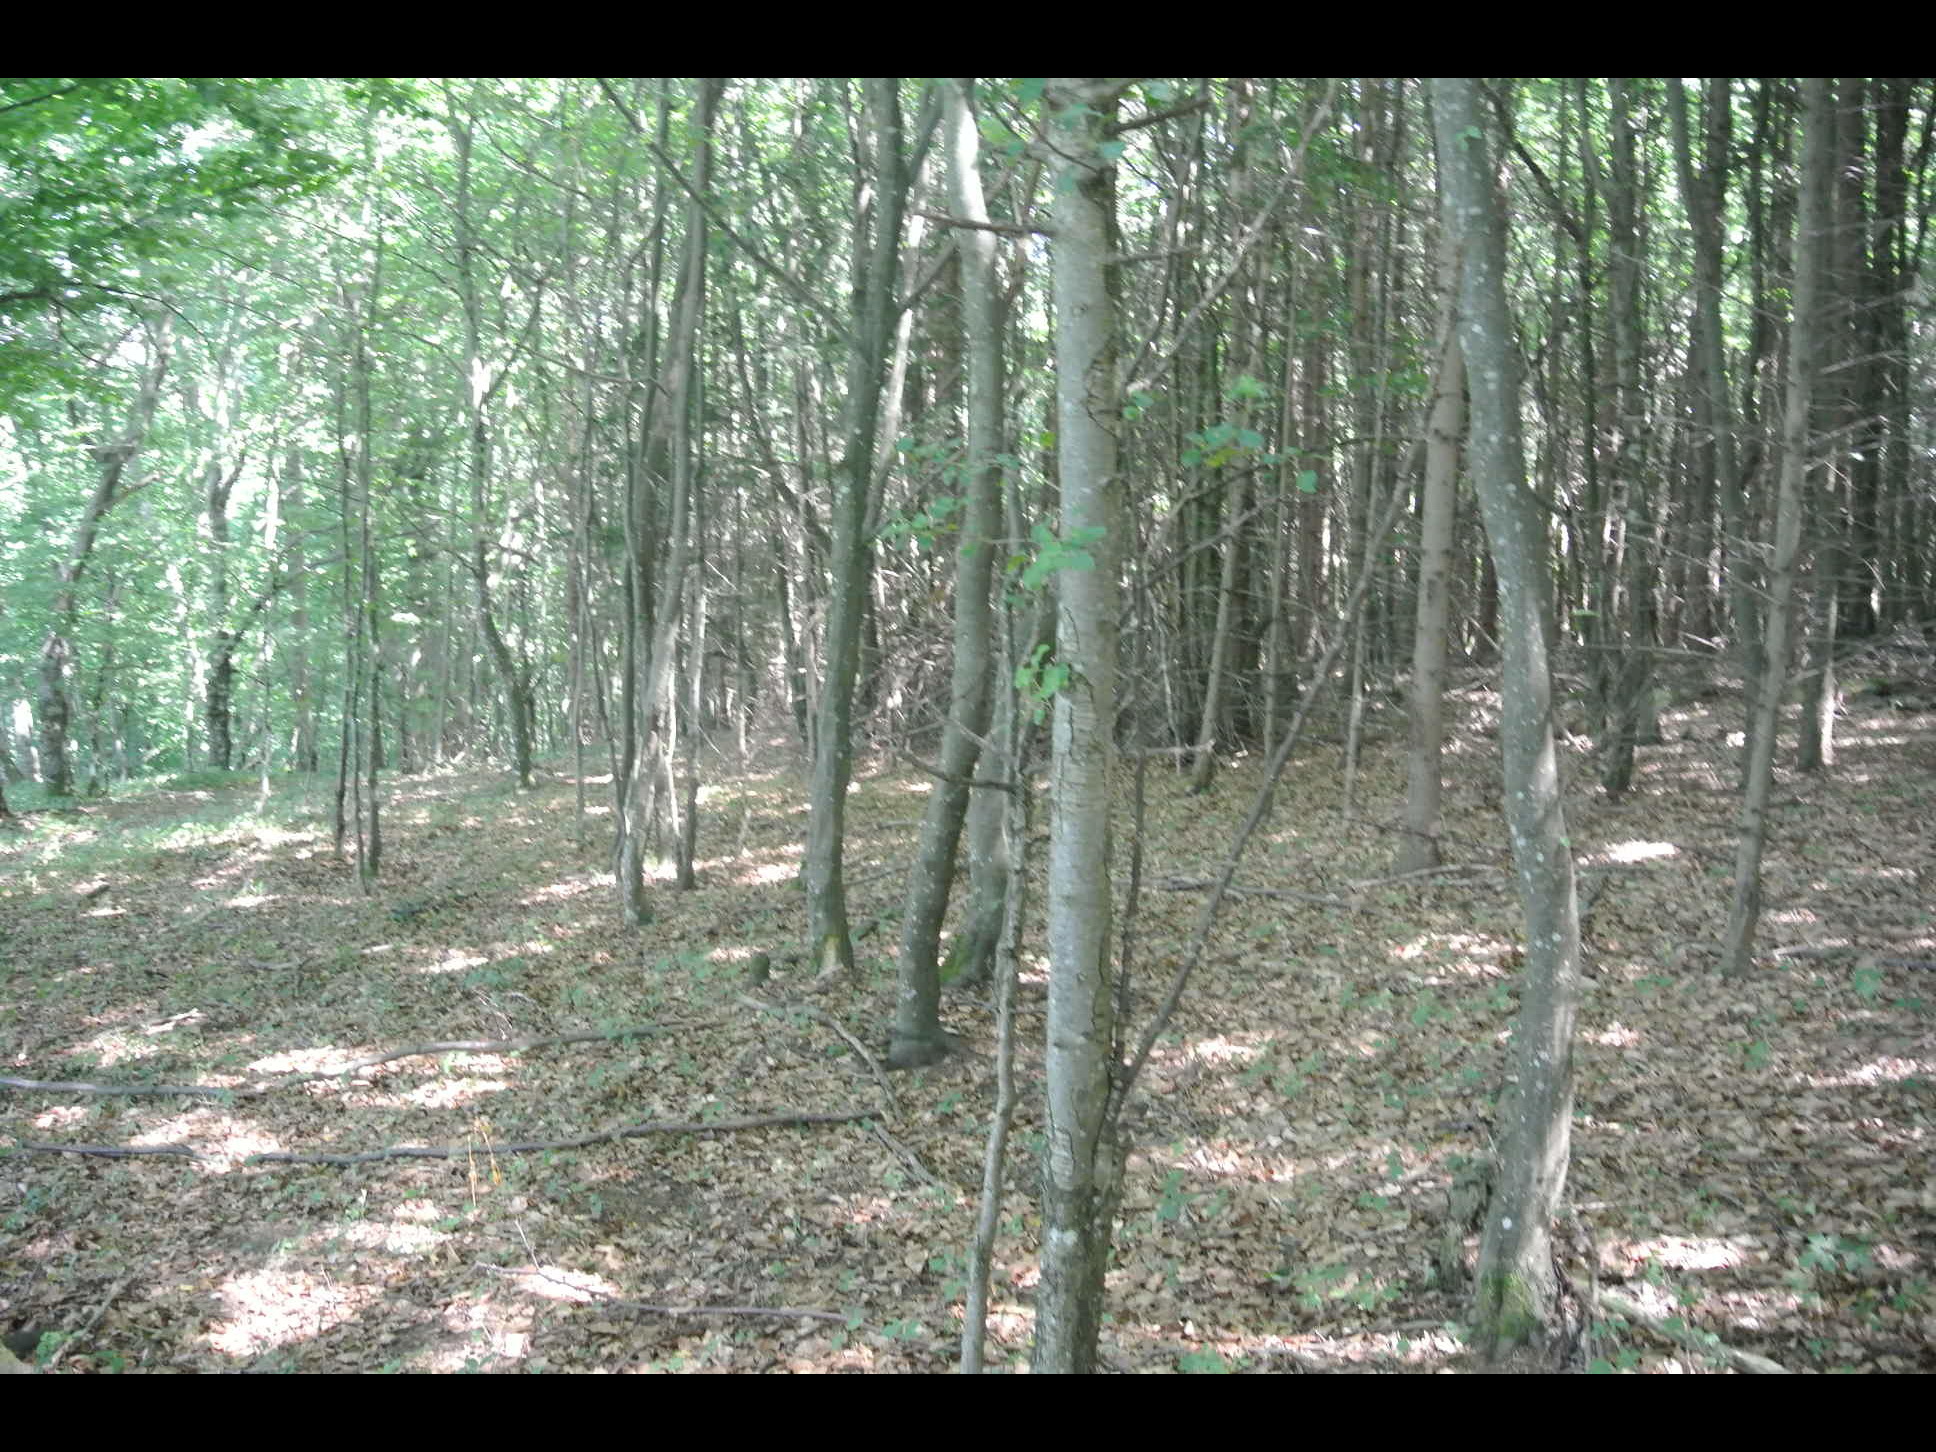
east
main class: Woodland
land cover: Spruce dominated mixed woodland
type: alpine coniferous forest
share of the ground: > 75 %
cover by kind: broadleaved forest trees 70 %, coniferous forest trees 30 %
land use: Forestry
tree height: > 5 m
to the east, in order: Spruce dominated mixed woodland; Spruce dominated coniferous woodland; Spruce dominated mixed woodland; Broadleaved woodland; Spruce dominated mixed woodland; Spruce dominated coniferous woodland
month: July
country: AT
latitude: 48.0095
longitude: 15.5921
